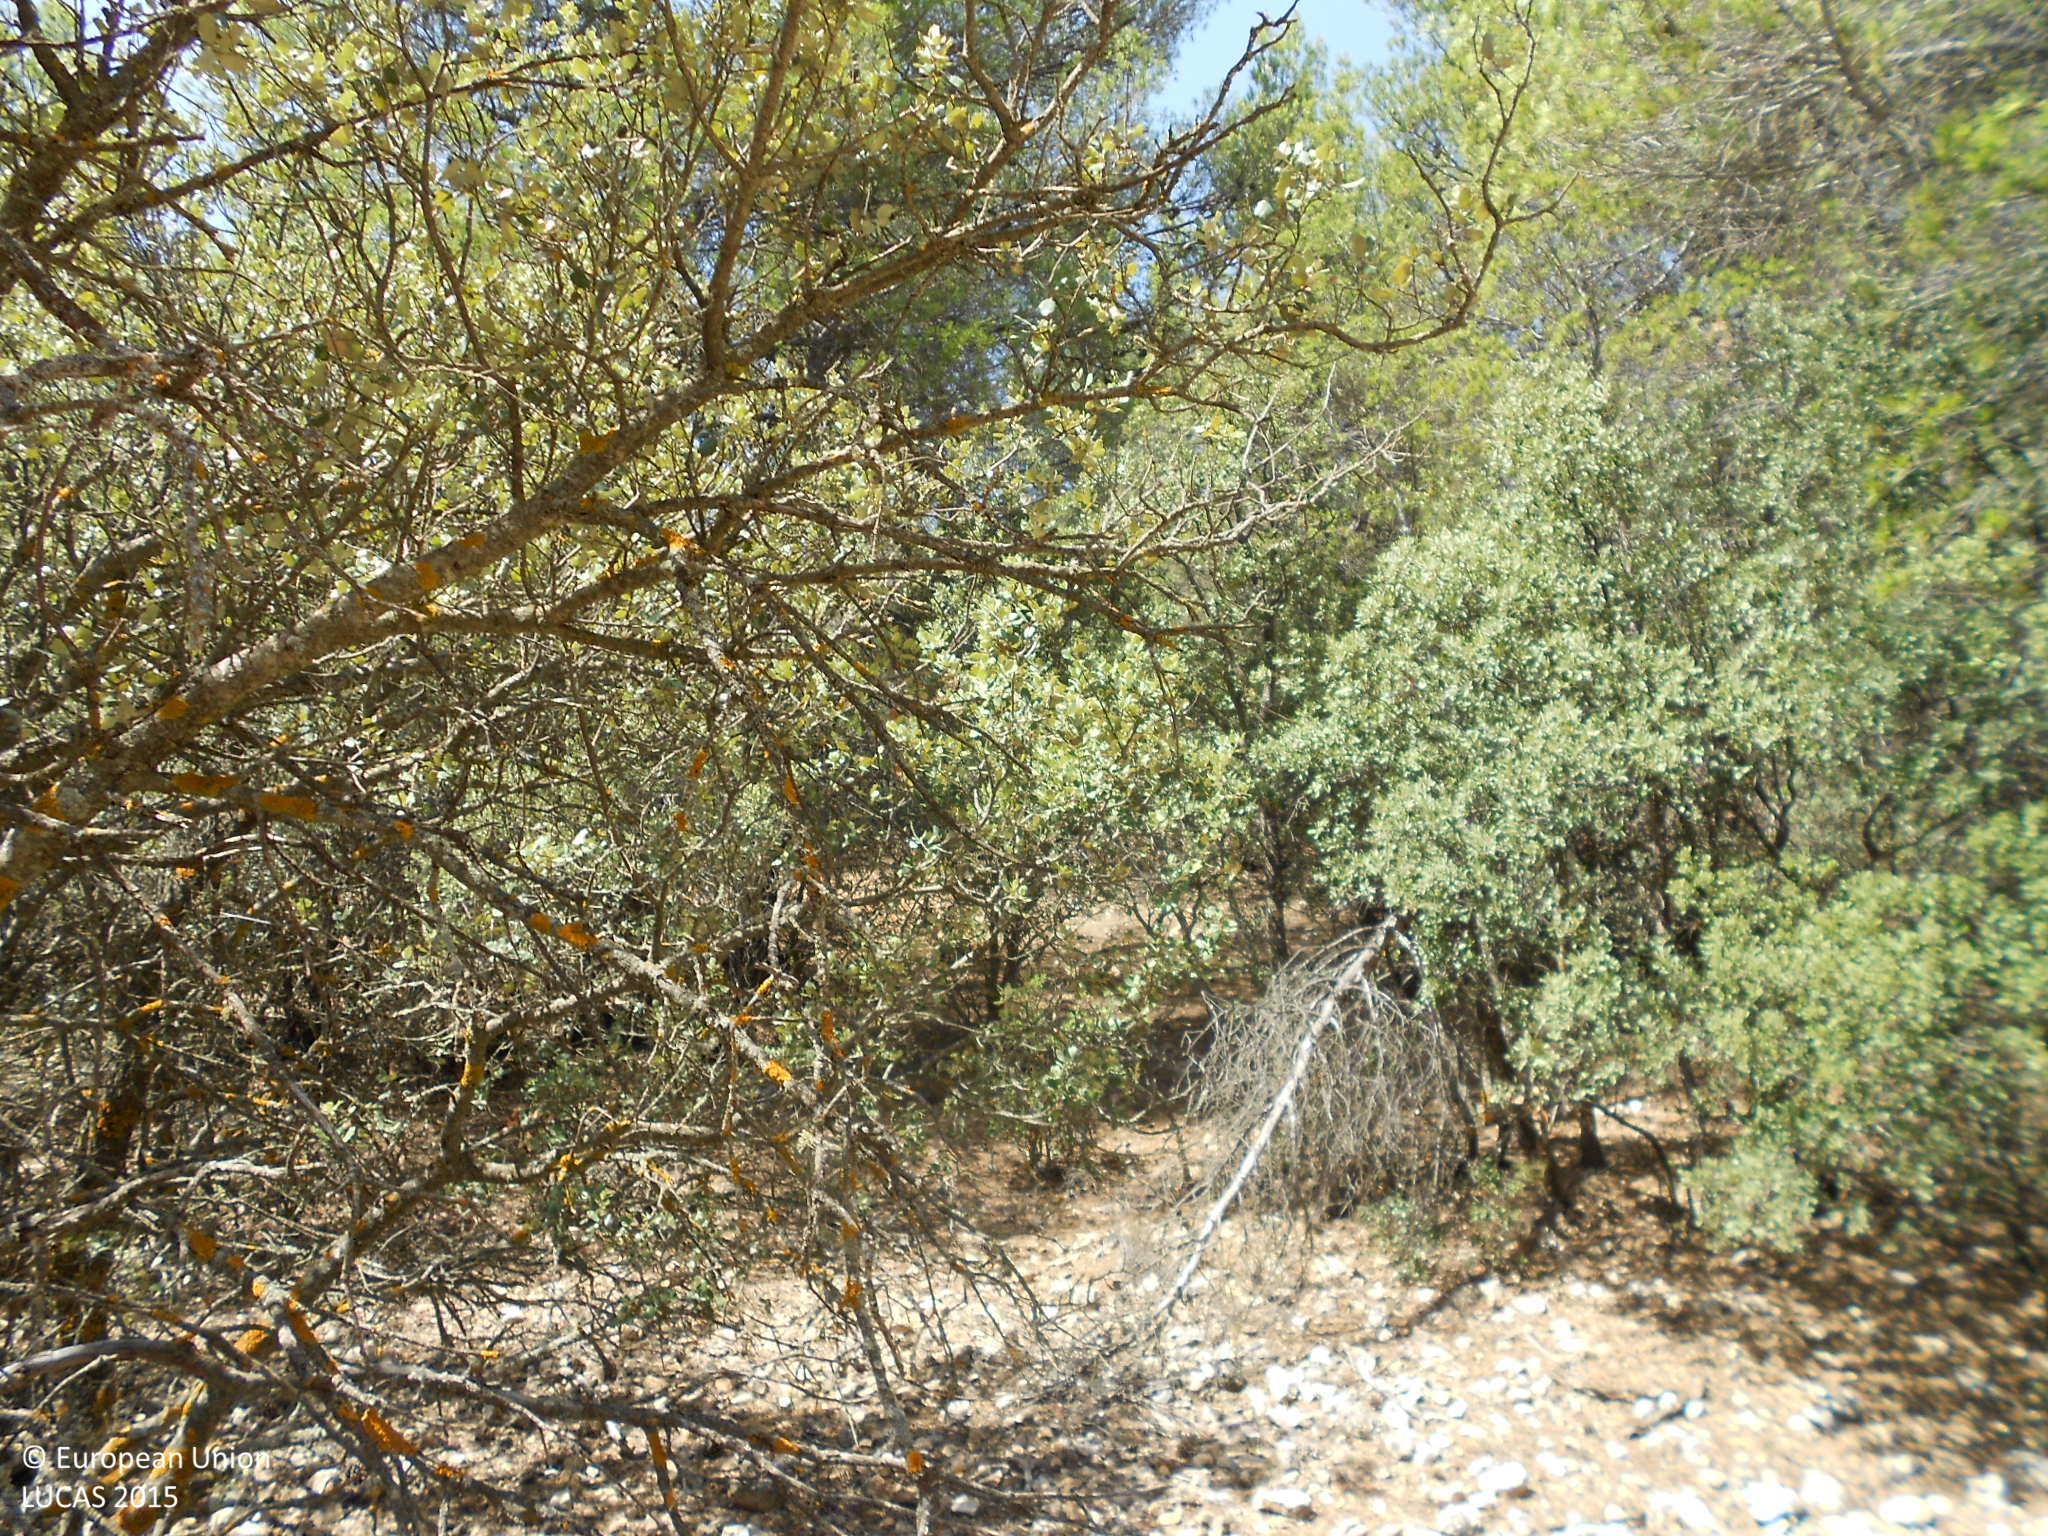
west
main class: Woodland
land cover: Other mixed woodland
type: coniferous forest of the mediterranean region
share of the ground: > 75 %
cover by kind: coniferous forest trees 40 %, broadleaved forest trees 40 %, shrubs 20 %
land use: Semi-natural and natural areas not in use
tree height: > 5 m
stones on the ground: 25 - 50 %
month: August
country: ES
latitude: 37.6859
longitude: -2.2443
